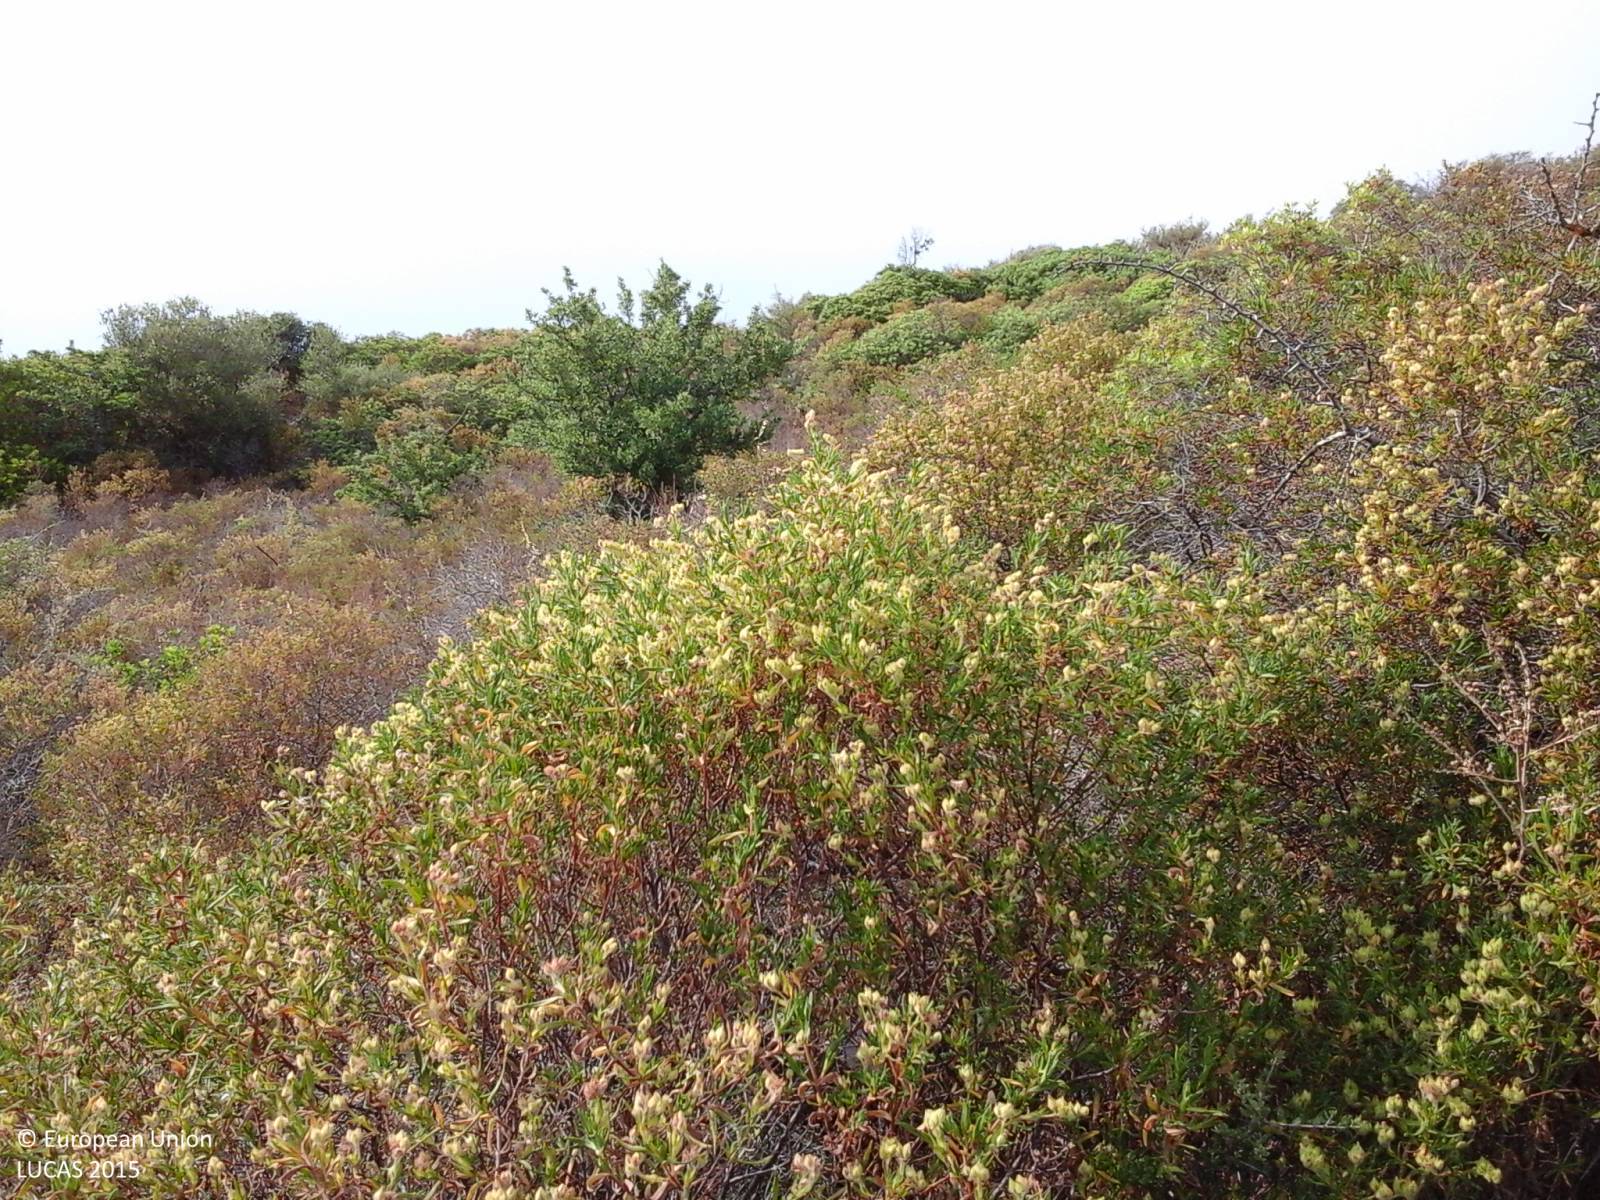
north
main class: Shrubland
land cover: Shrubland without tree cover
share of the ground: > 75 %
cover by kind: shrubs 70 %, herbaceous plants 30 %
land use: Agriculture (excluding fallow land and kitchen gardens)
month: June
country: IT
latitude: 39.6040
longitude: 8.5063
